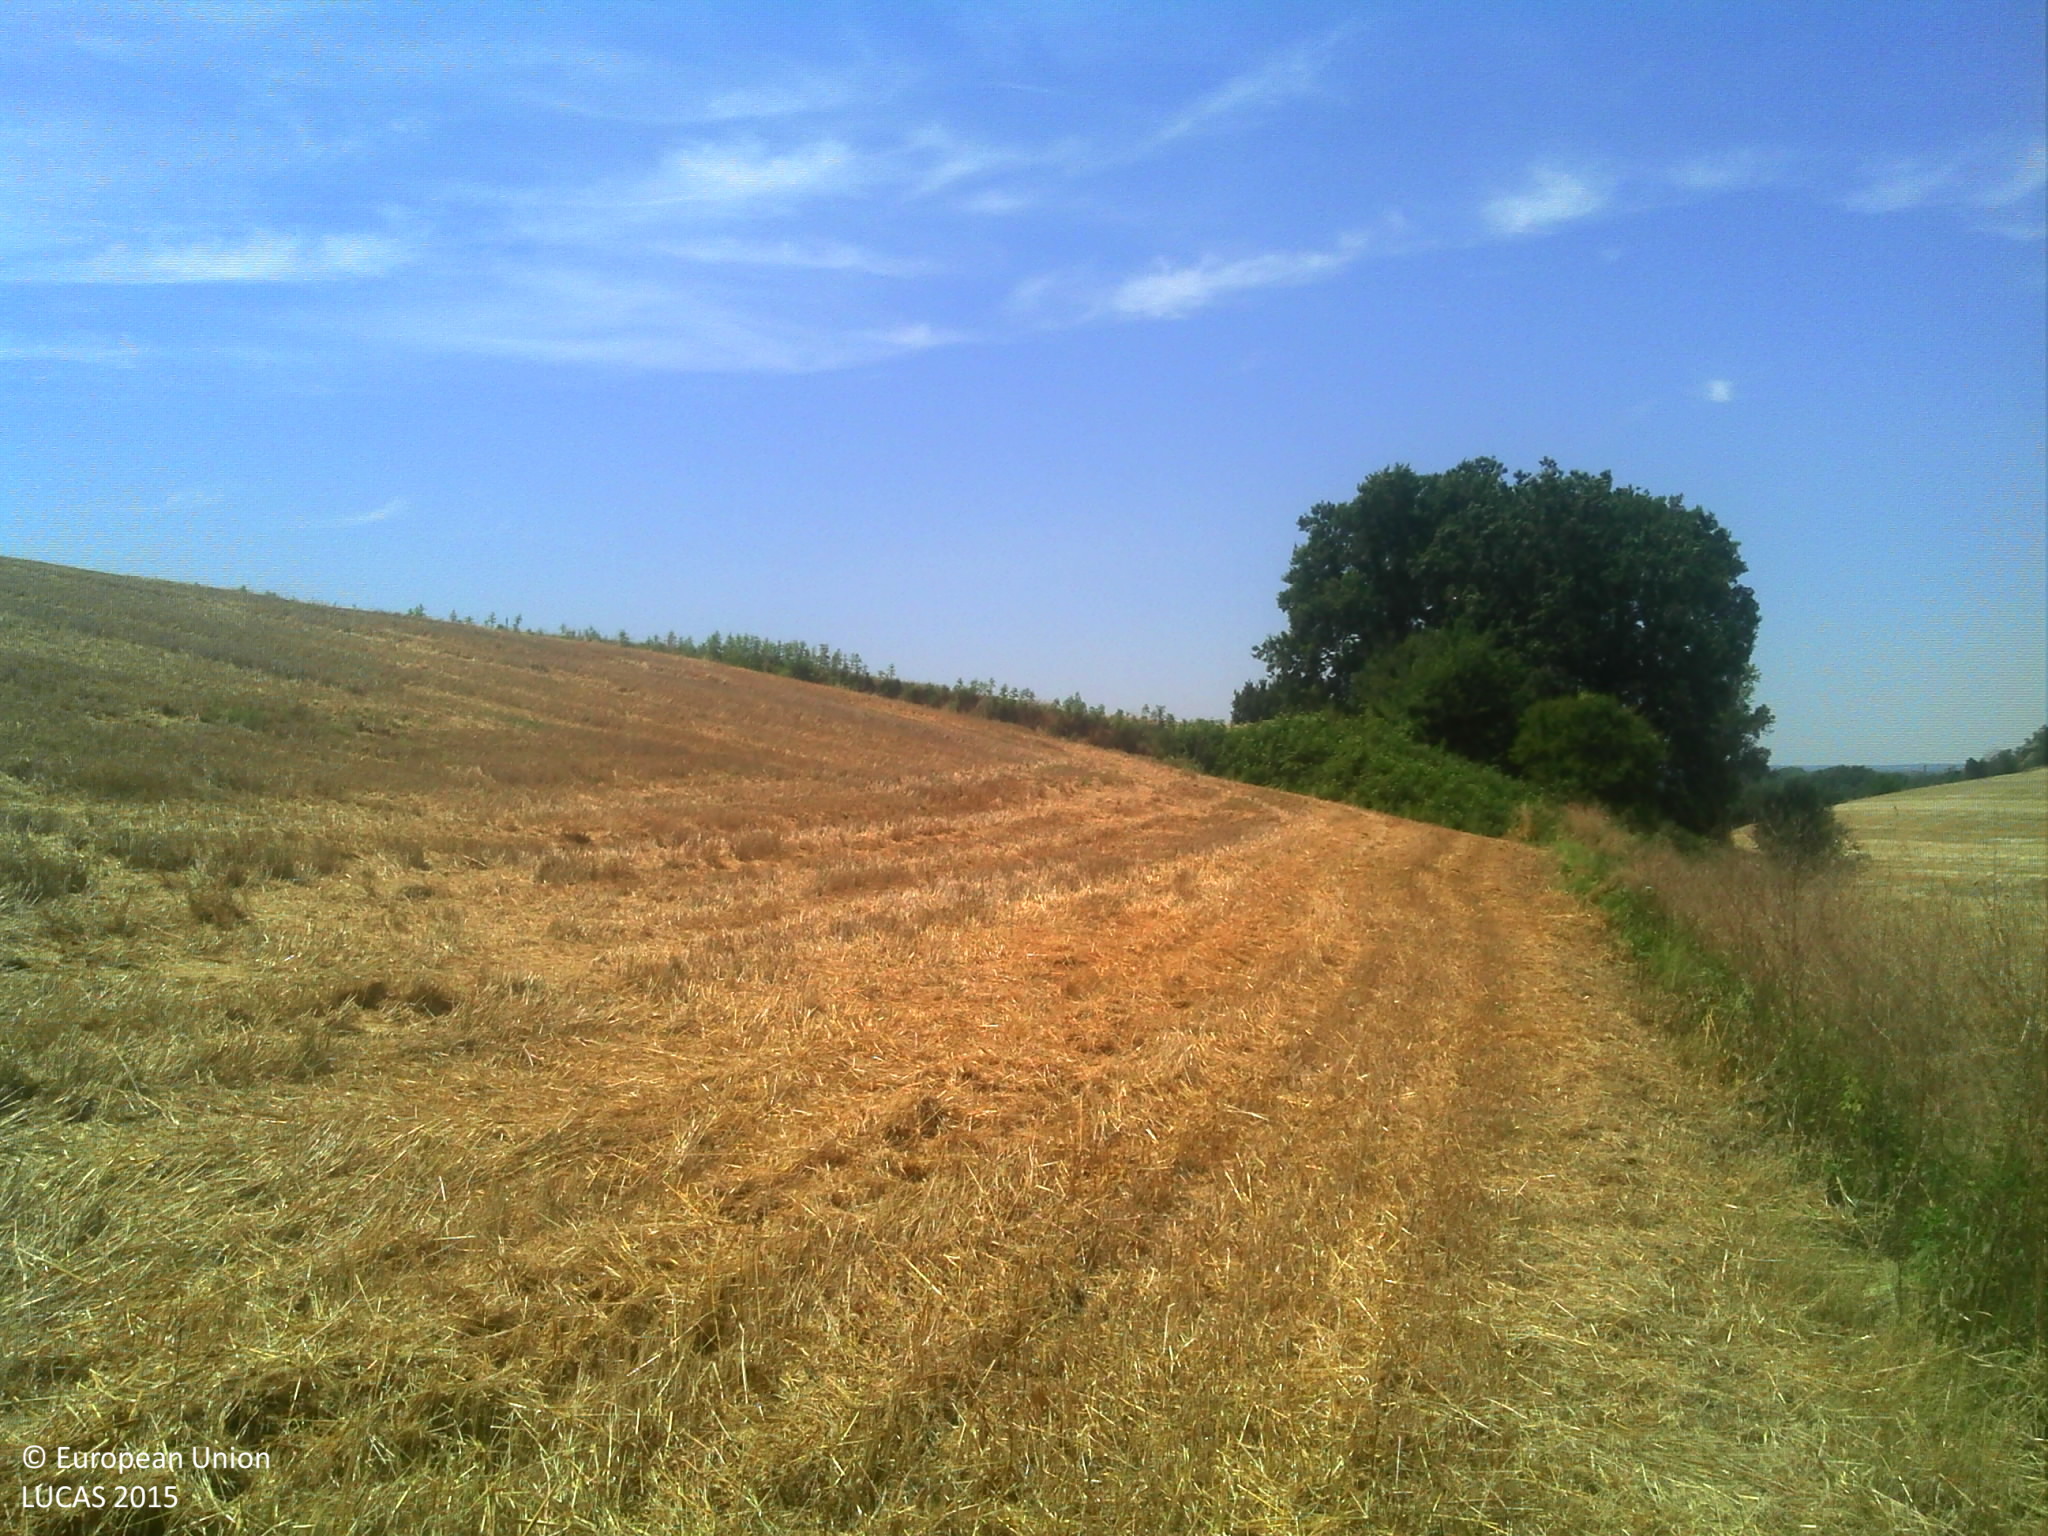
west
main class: Cropland
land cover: Common wheat
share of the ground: > 75 %
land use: Agriculture (excluding fallow land and kitchen gardens)
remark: Harvested field
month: July
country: FR
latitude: 43.4523
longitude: 1.4395
